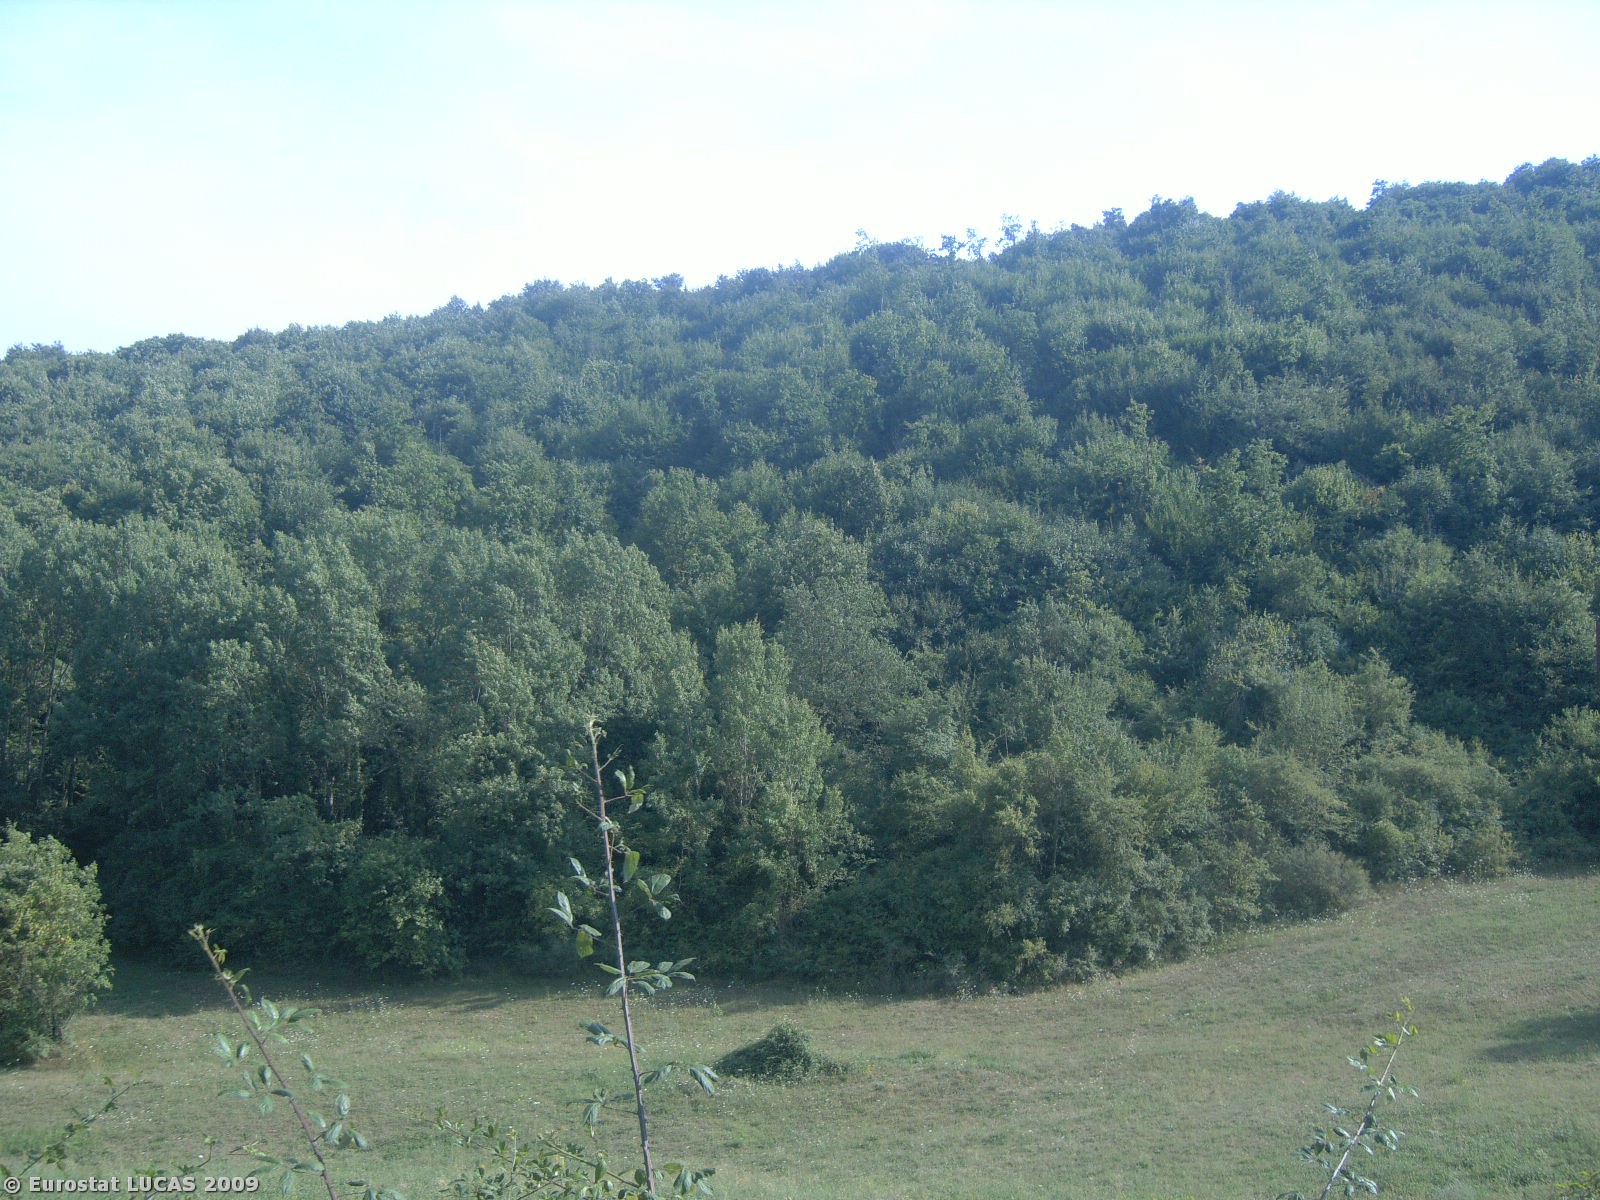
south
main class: Woodland
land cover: Broadleaved woodland
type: thermophilous deciduous forest
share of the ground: > 75 %
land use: Forestry
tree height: > 5 m
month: July
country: IT
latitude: 41.7899
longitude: 13.2011
